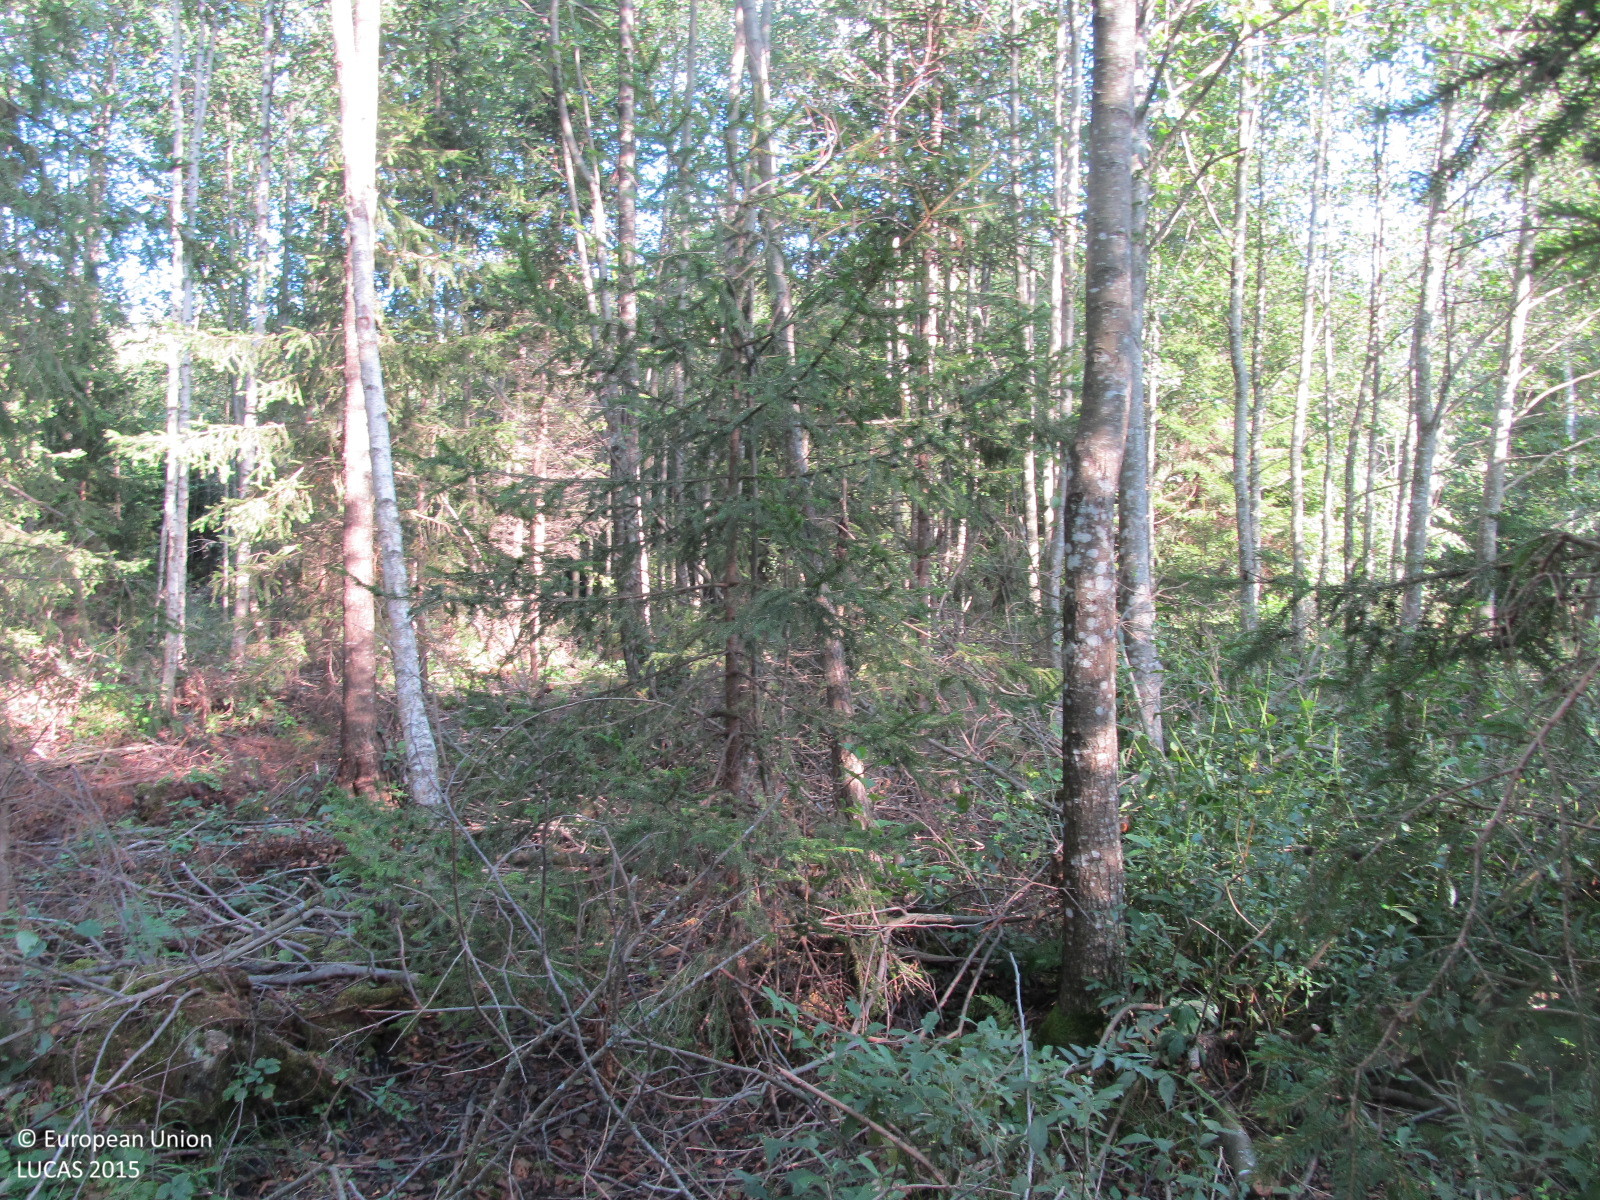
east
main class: Woodland
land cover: Broadleaved woodland
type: non-riverine alder, birch or aspen forest
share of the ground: 50 - 75 %
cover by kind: broadleaved forest trees 60 %, herbaceous plants 20 %, coniferous forest trees 10 %, lichens and mosses 5 %, unconsolidated bare surface 5 %
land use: Forestry
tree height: > 5 m
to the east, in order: Broadleaved woodland; Tracks; Other mixed woodland; Tracks; Spruce dominated mixed woodland
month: September
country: LT
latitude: 56.1221
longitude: 23.3771
